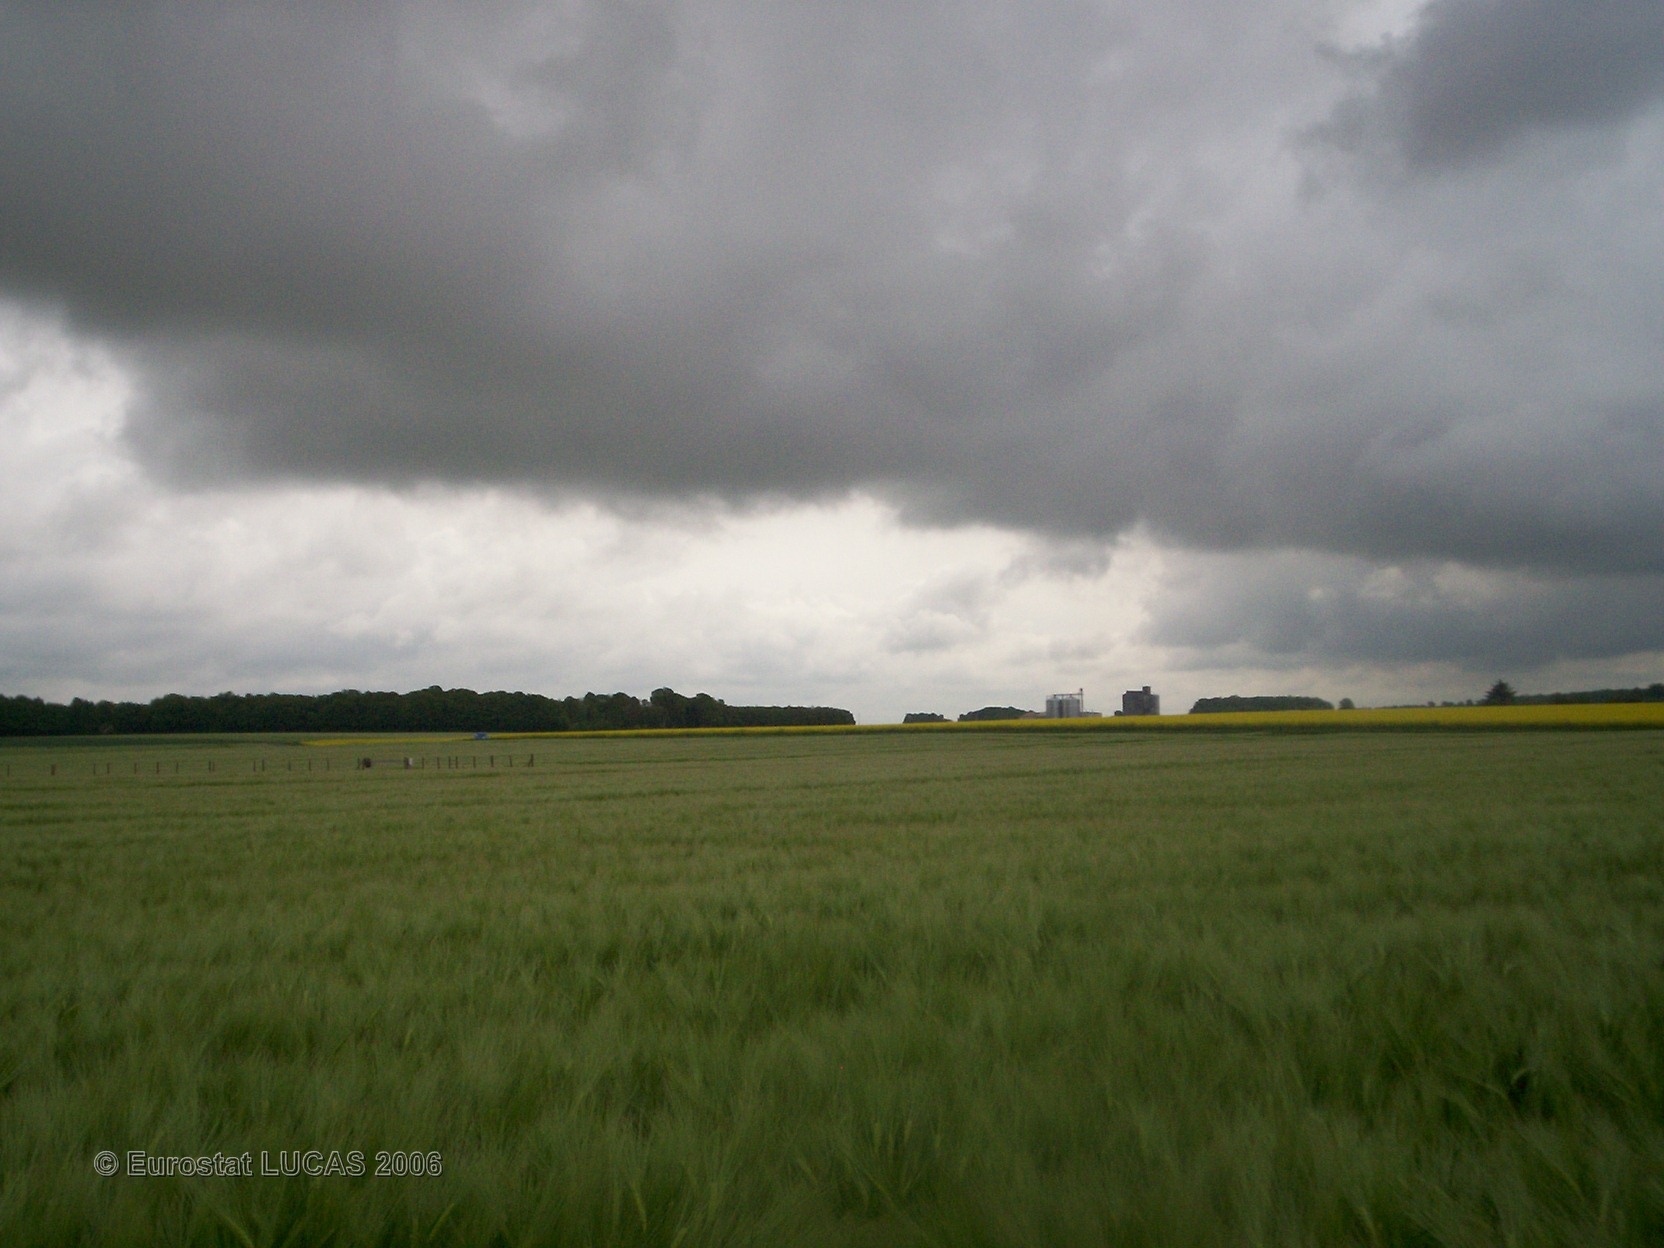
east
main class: Cropland
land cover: Barley
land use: Agriculture (excluding fallow land and kitchen gardens)
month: May
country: FR
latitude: 47.9785
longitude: 2.9324
